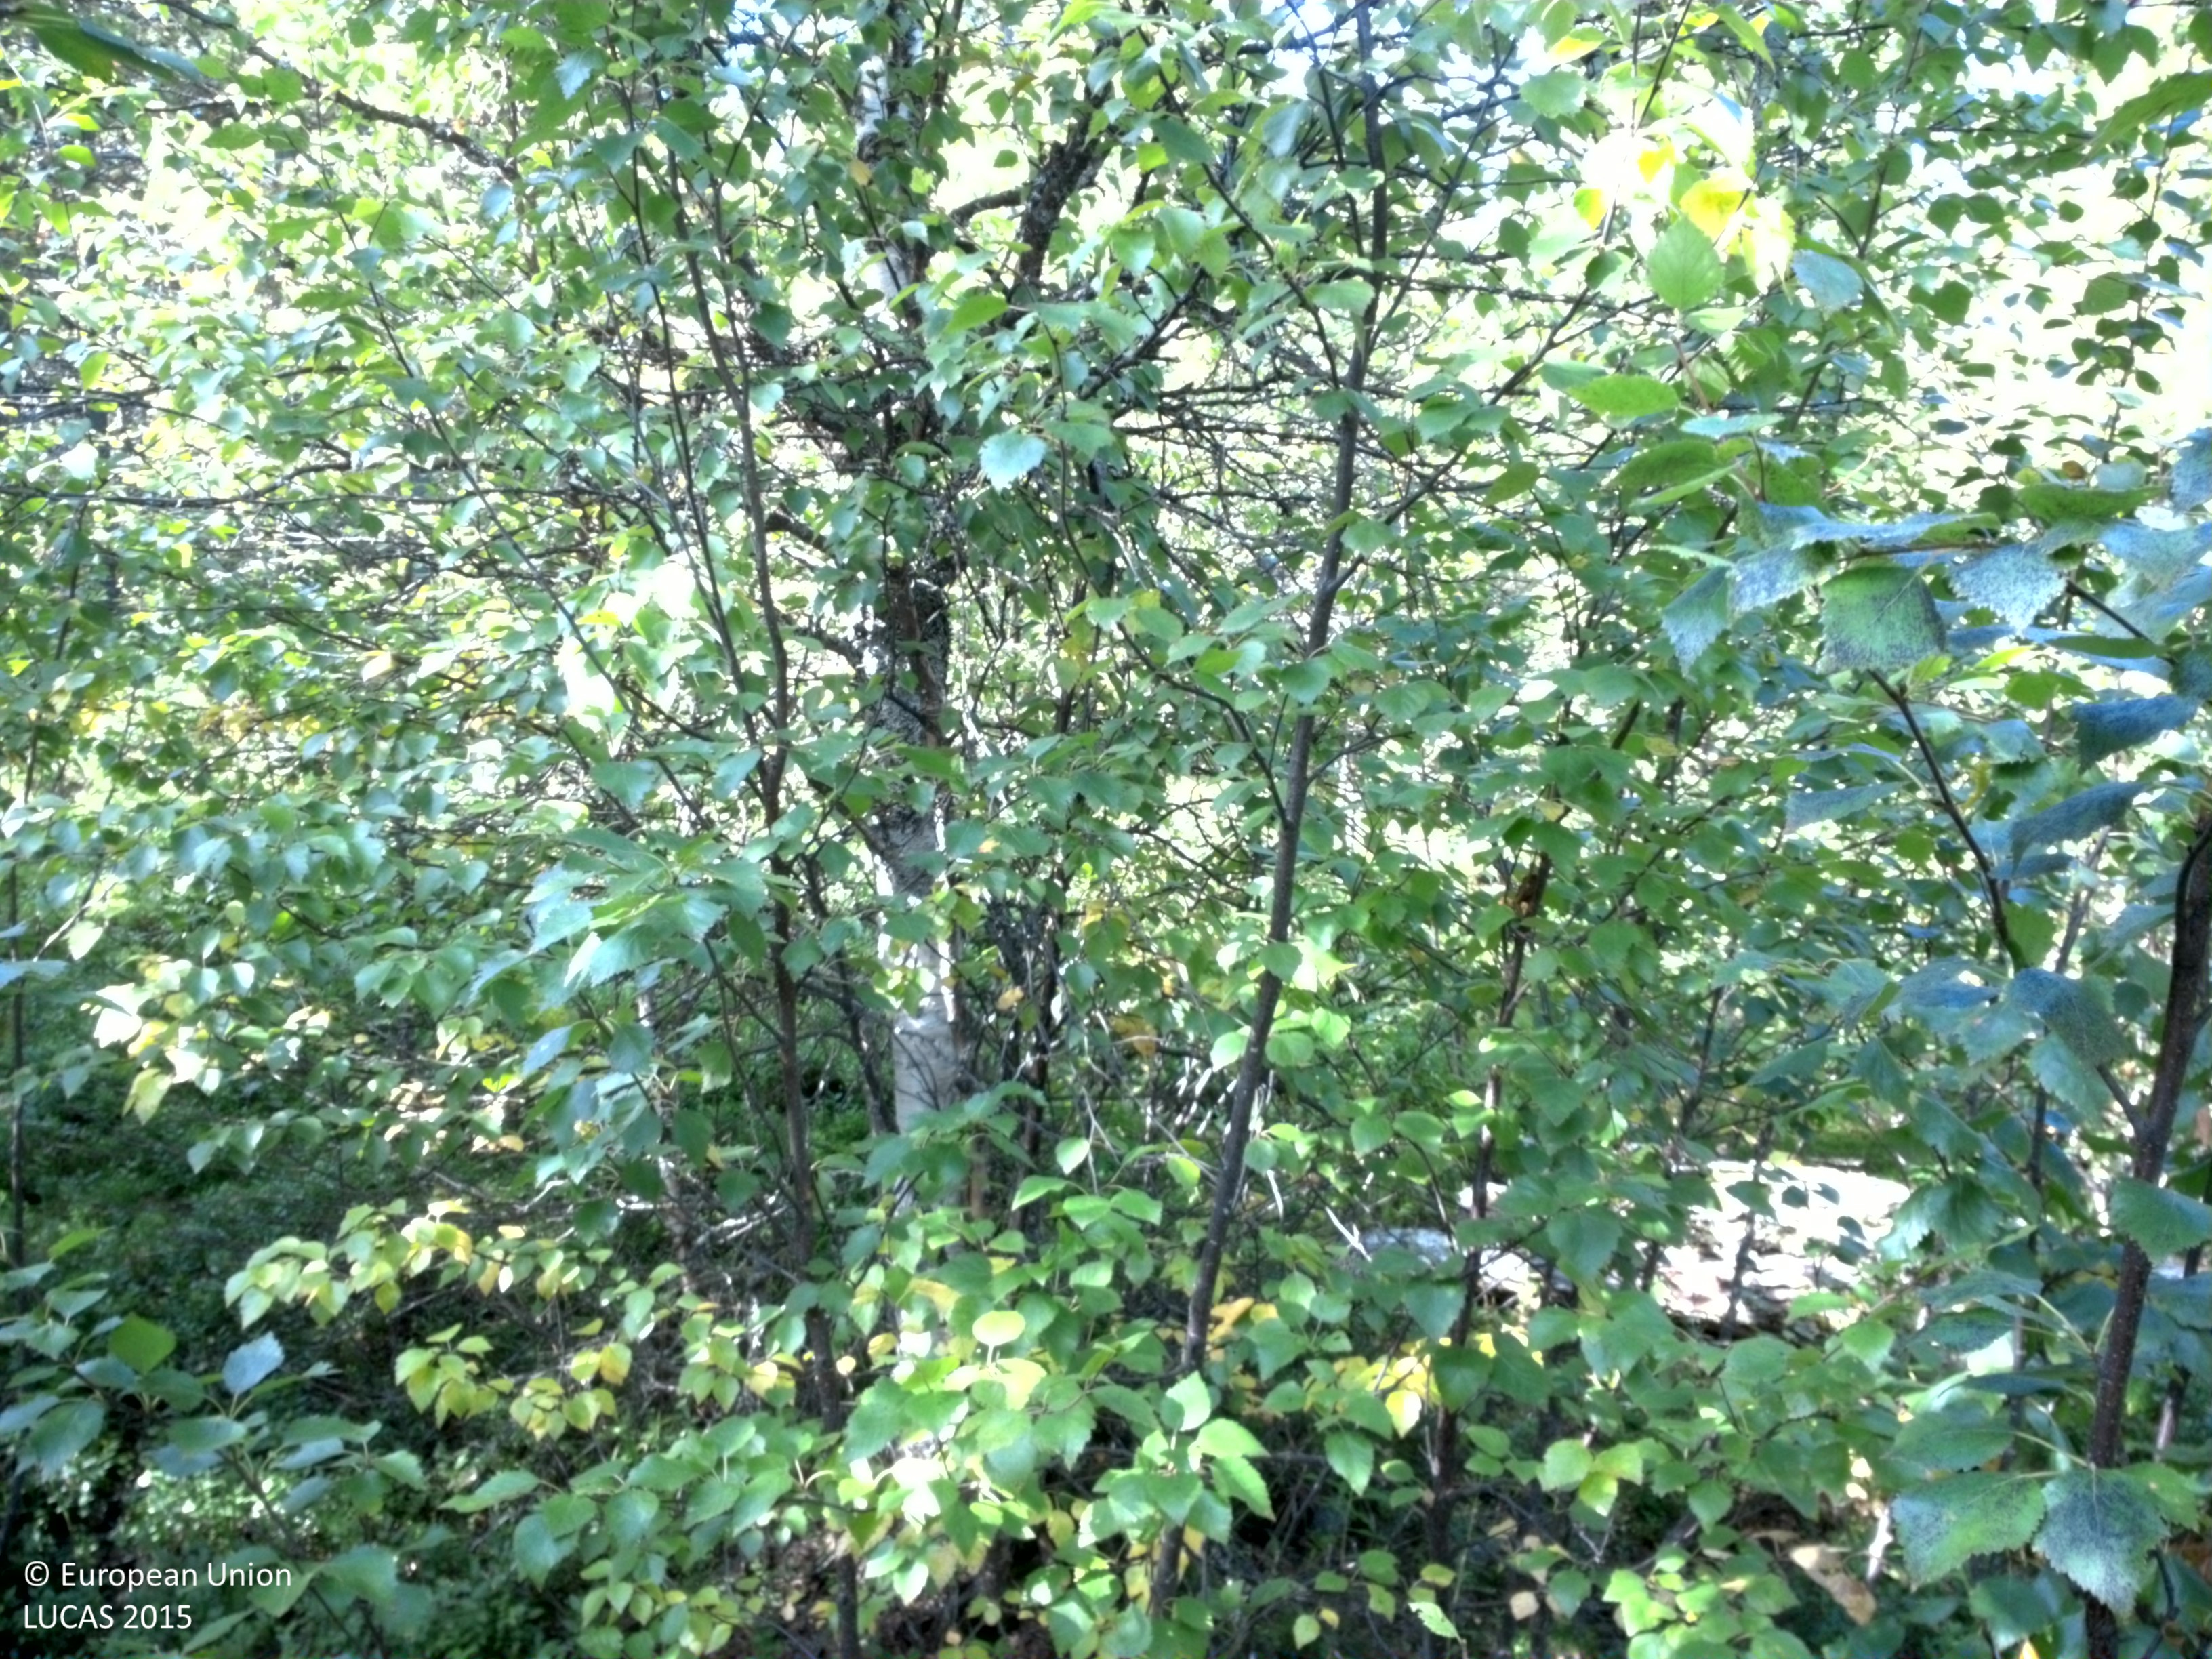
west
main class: Woodland
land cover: Pine dominated mixed woodland
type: exotic forest
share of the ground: 50 - 75 %
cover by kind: coniferous forest trees 35 %, shrubs 25 %, herbaceous plants 20 %, broadleaved forest trees 15 %, lichens and mosses 5 %
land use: Forestry
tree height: > 5 m
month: September
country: SE
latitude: 65.0614
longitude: 16.5322
